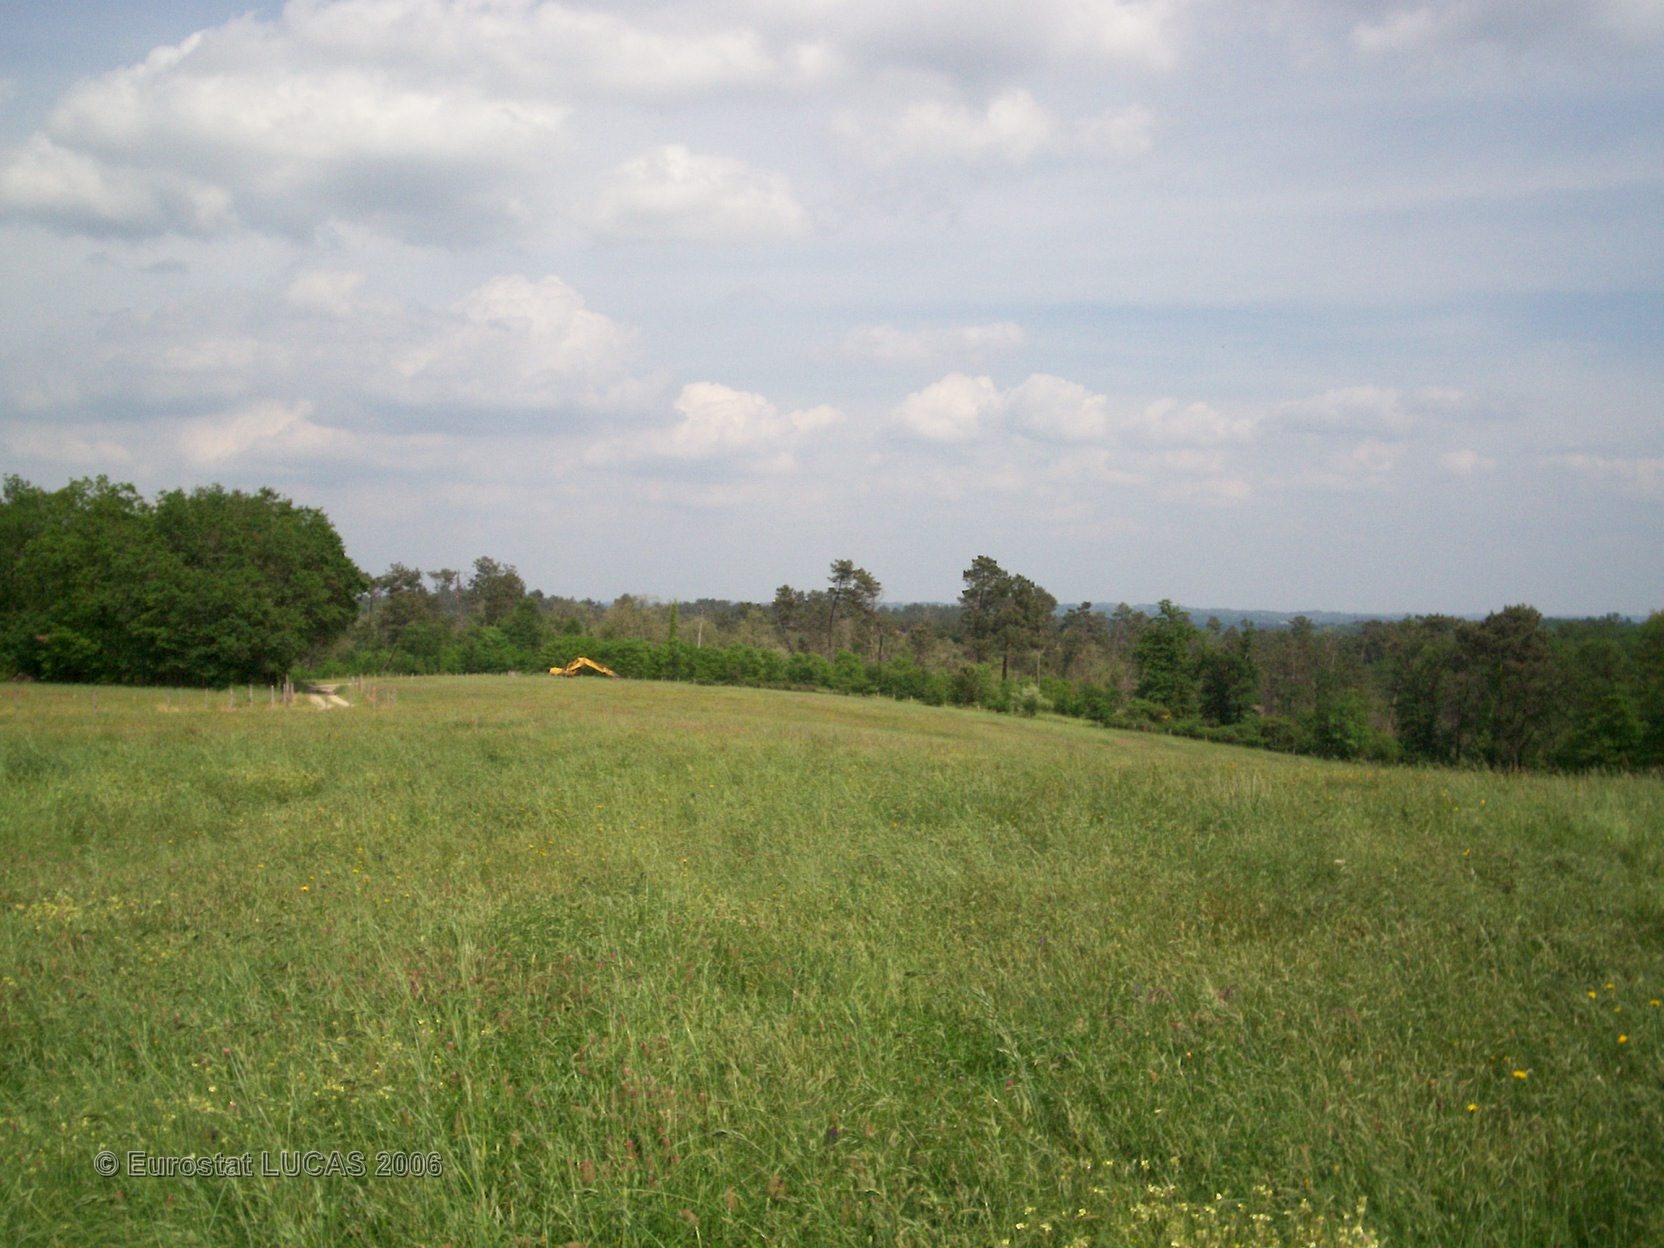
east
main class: Grassland
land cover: Grassland without tree/shrub cover
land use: Agriculture (excluding fallow land and kitchen gardens)
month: May
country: FR
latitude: 45.1482
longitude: -0.0763
